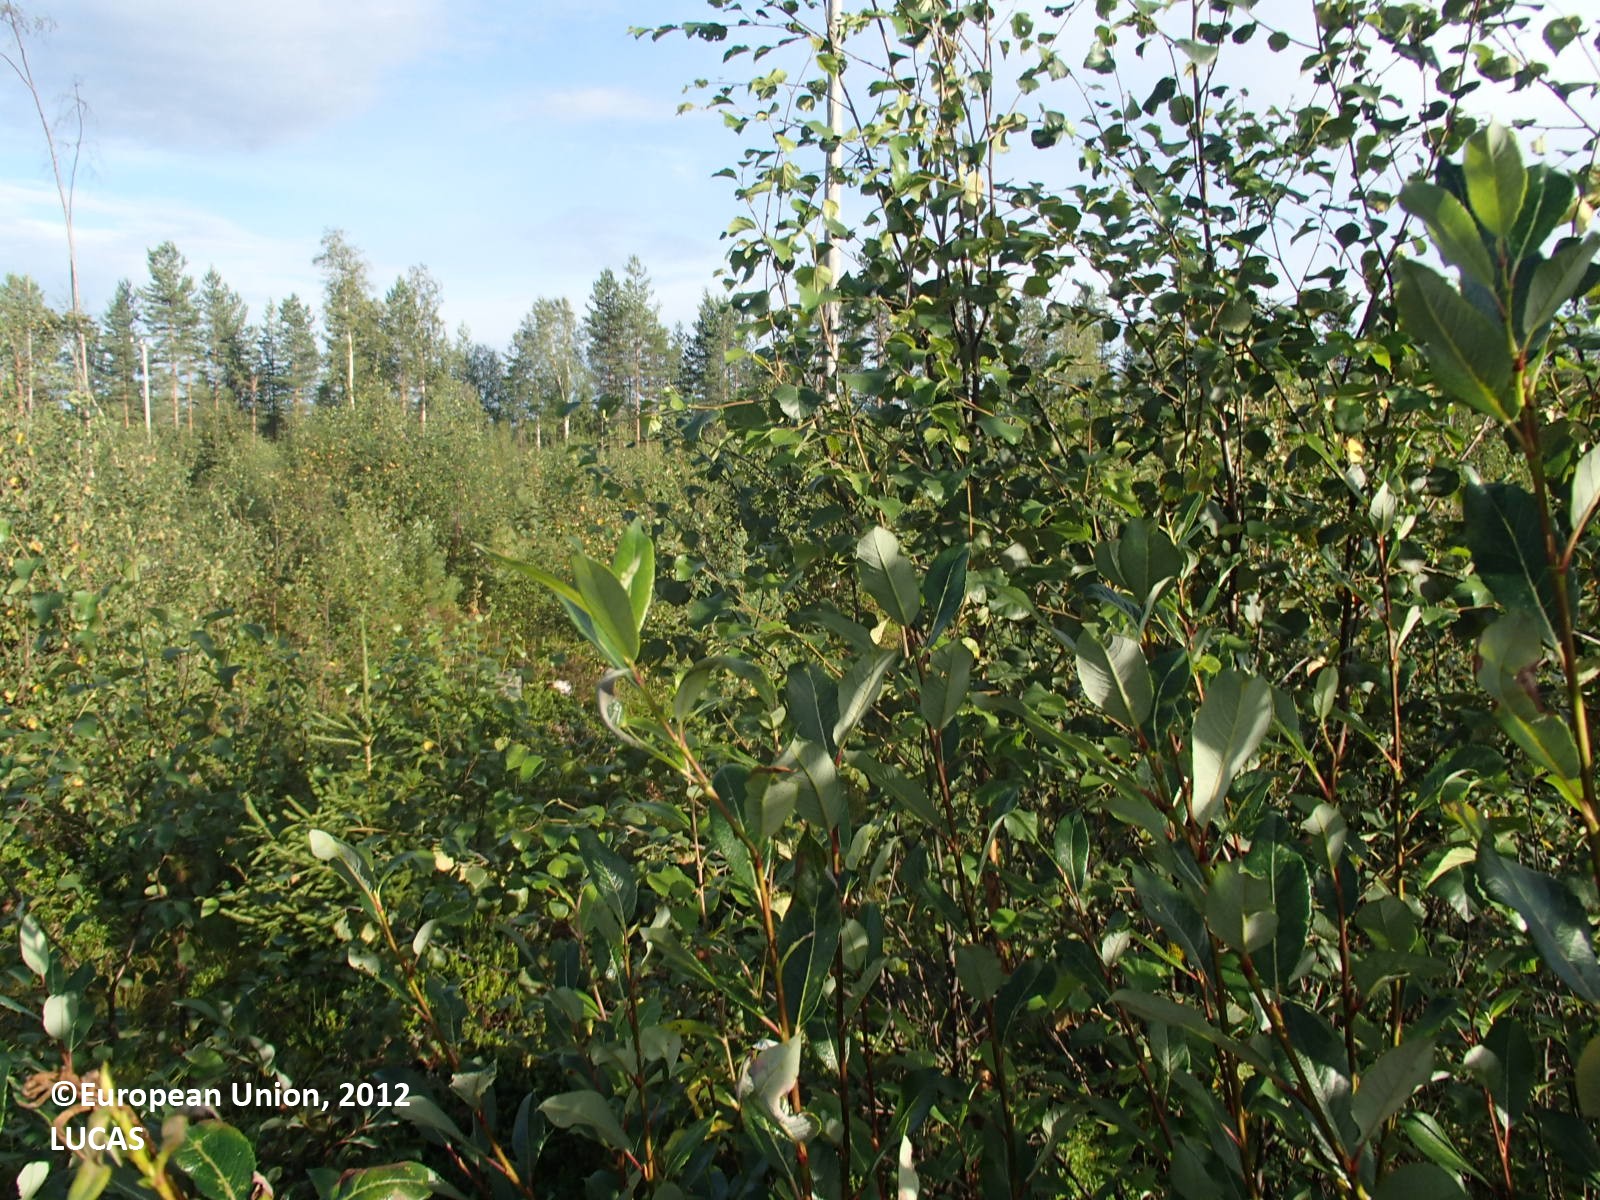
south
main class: Woodland
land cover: Other mixed woodland
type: boreal forest
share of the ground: > 75 %
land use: Forestry
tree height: < 5 m
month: August
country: FI
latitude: 63.8130
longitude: 28.0636
